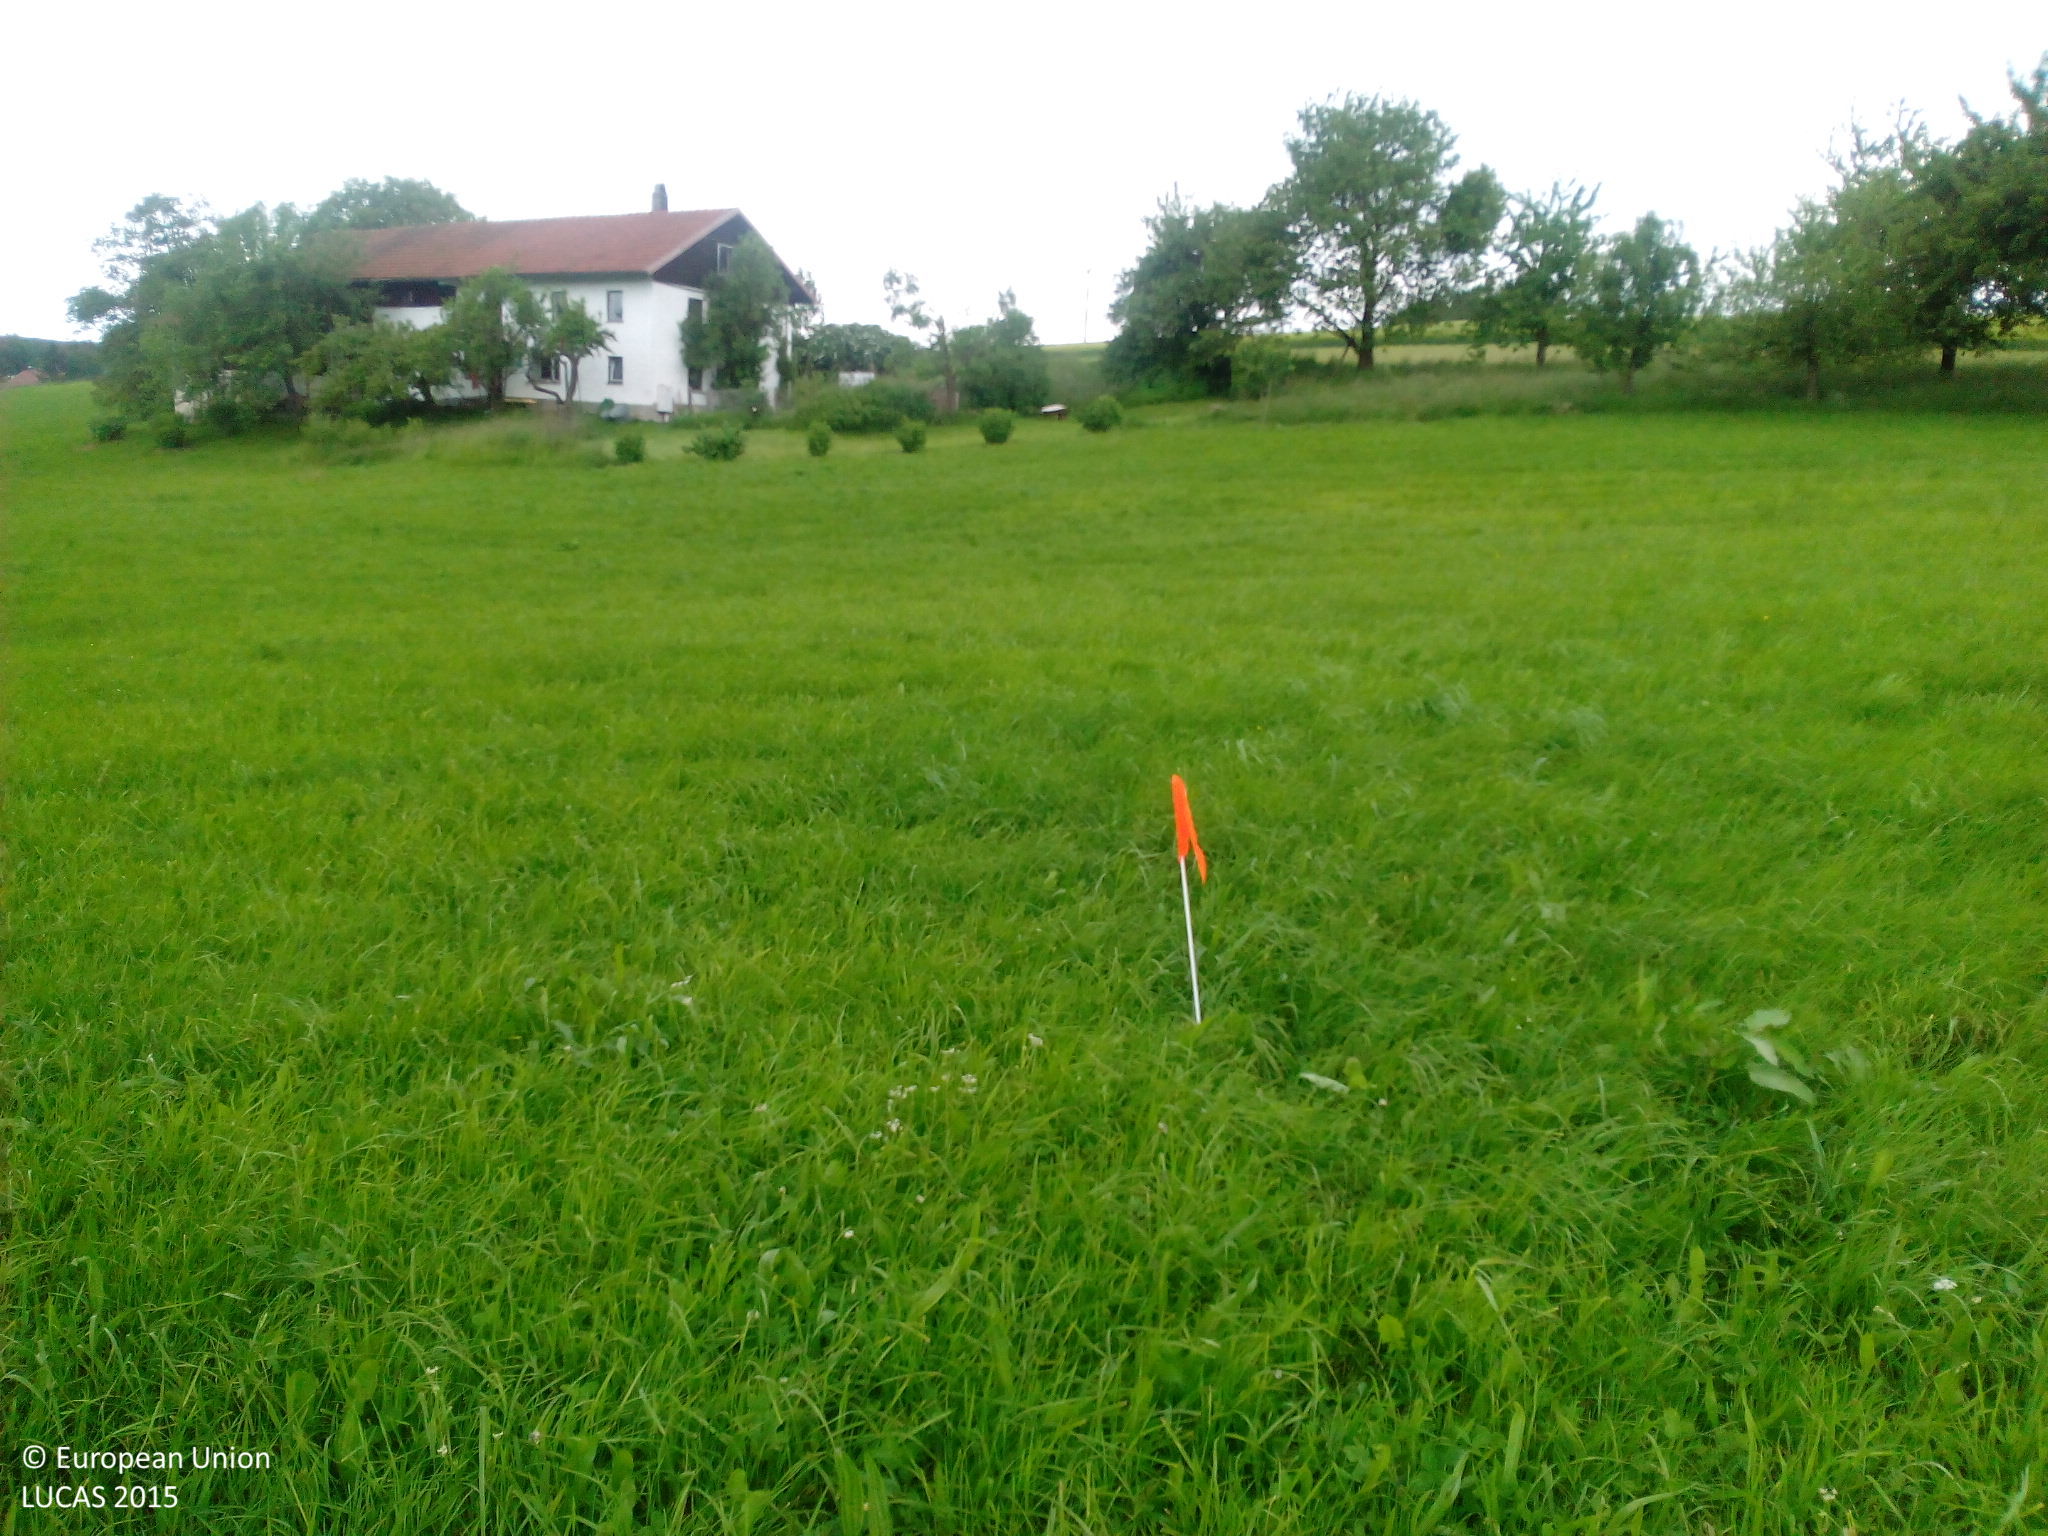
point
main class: Grassland
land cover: Grassland without tree/shrub cover
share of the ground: > 75 %
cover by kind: herbaceous plants 100 %
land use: Agriculture (excluding fallow land and kitchen gardens)
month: May
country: DE
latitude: 48.3609
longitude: 12.3340
